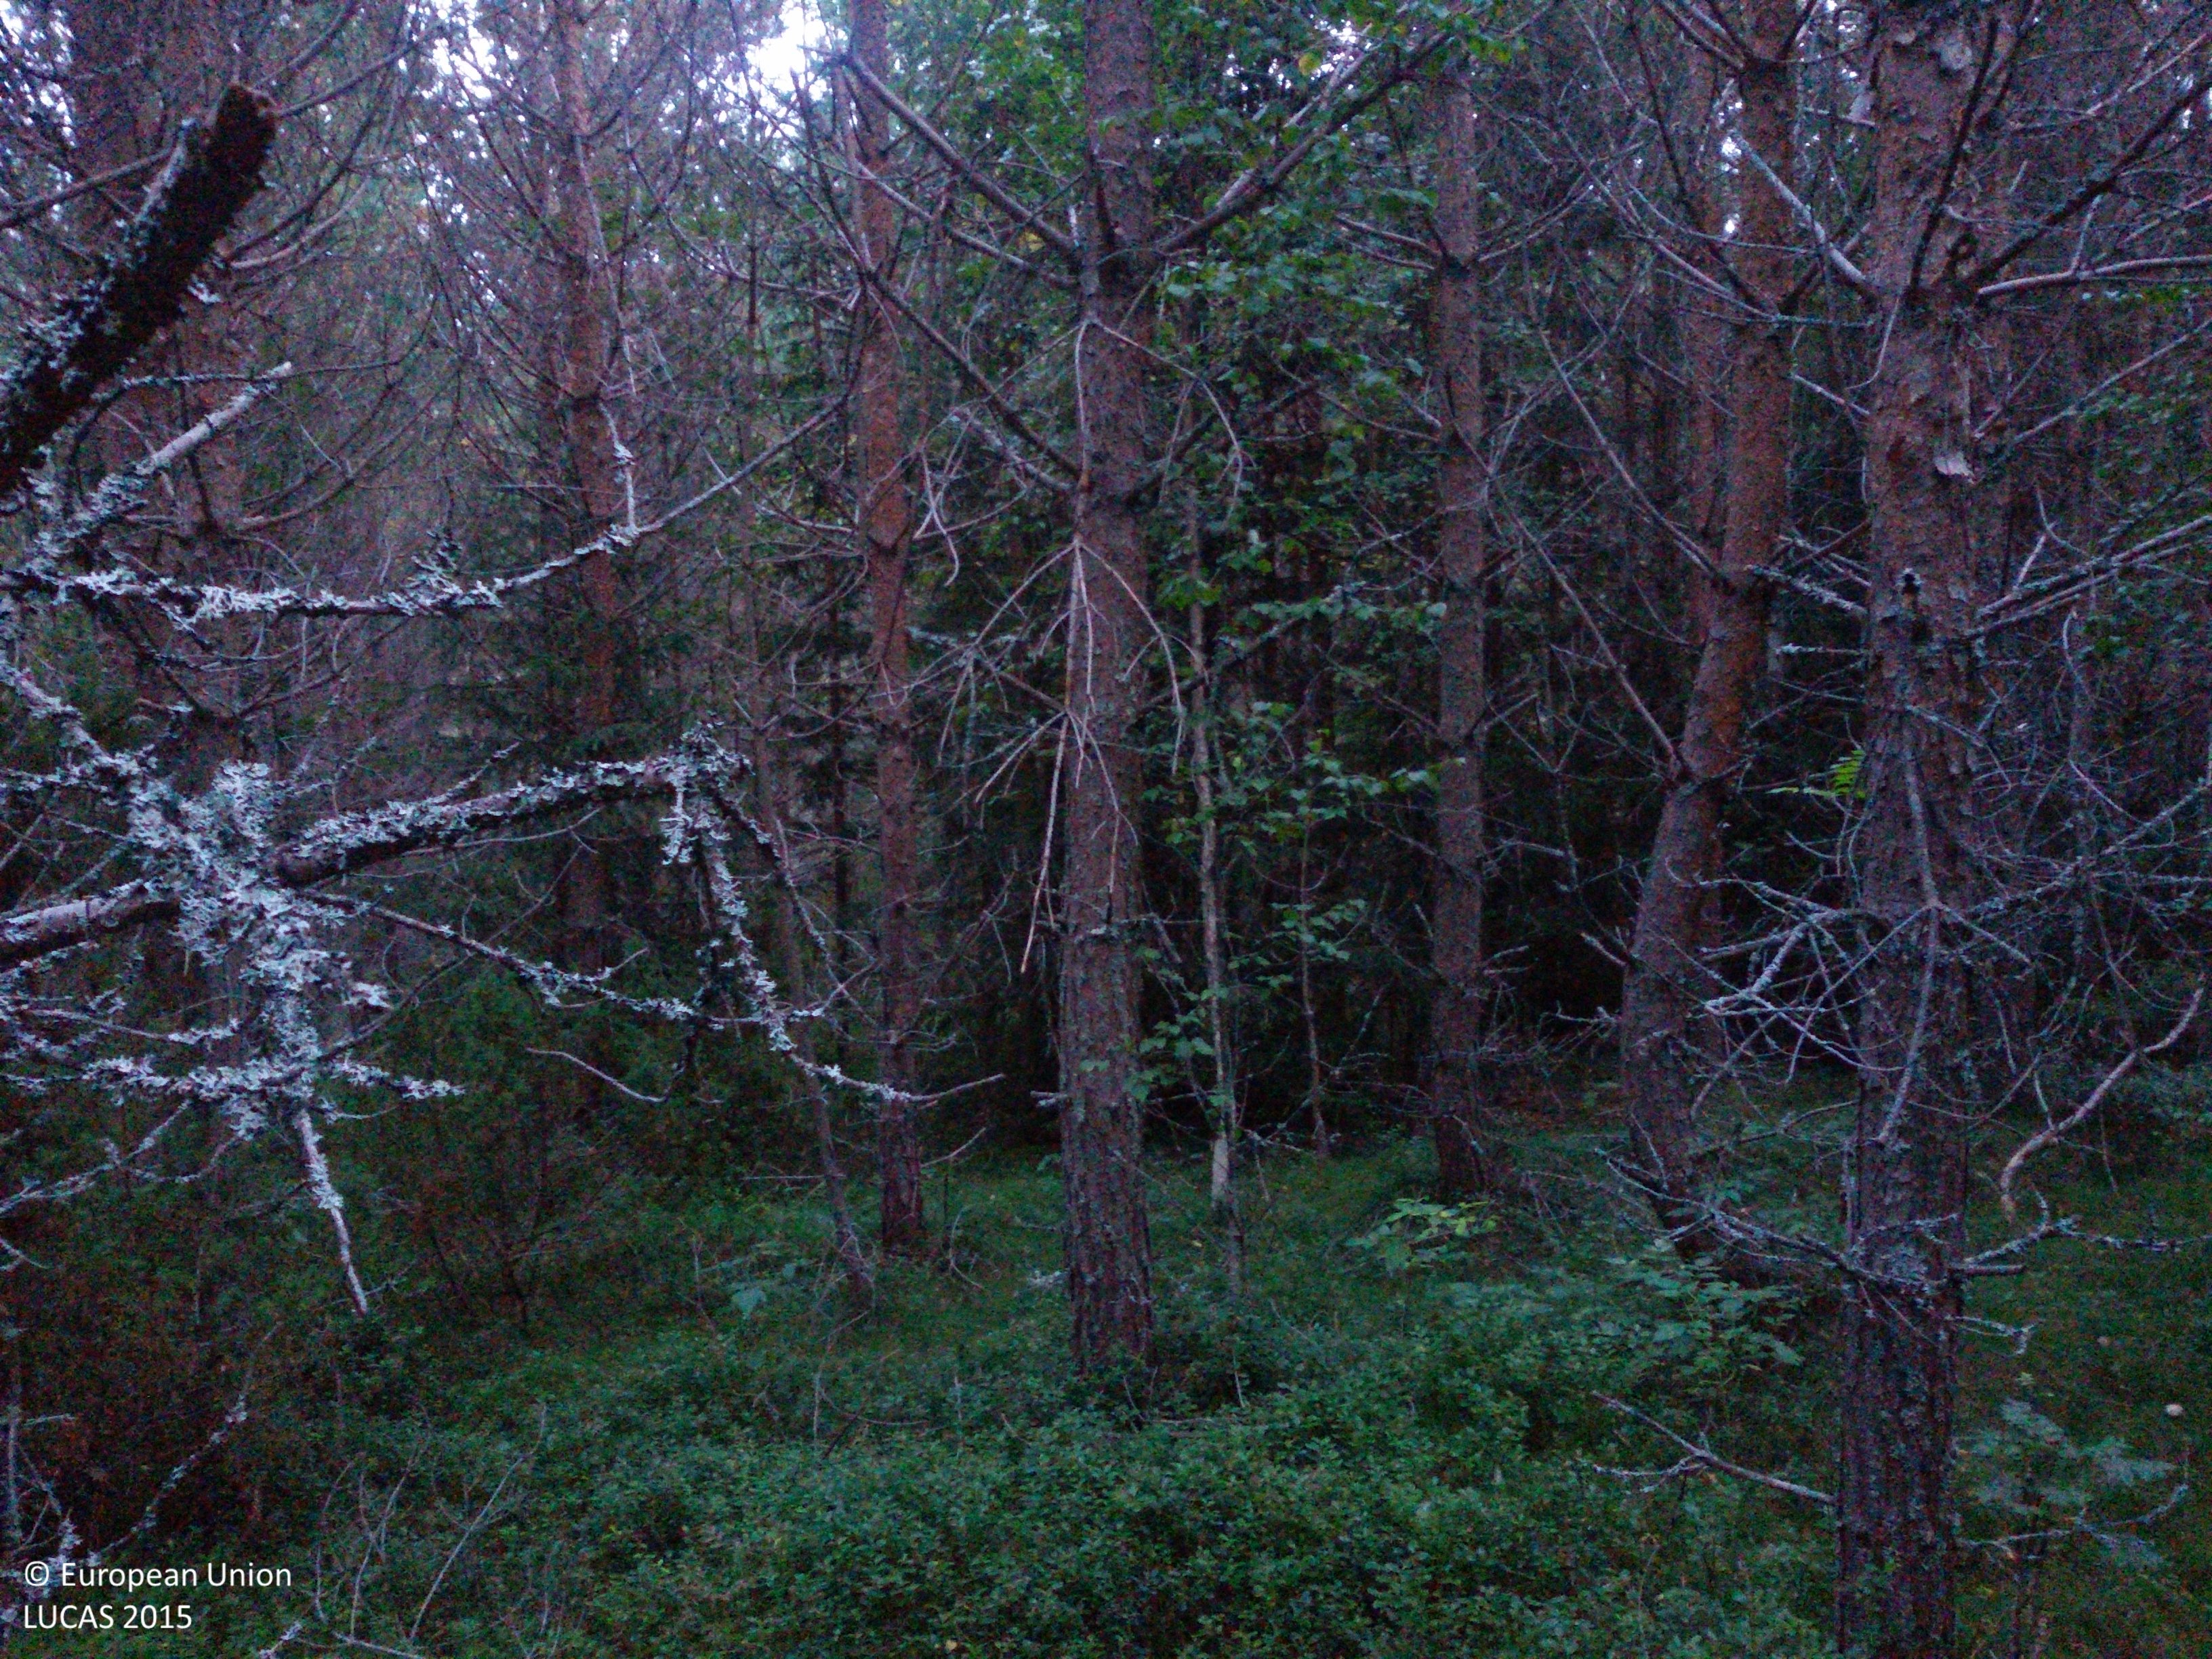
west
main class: Woodland
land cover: Pine dominated coniferous woodland
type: boreal forest
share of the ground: > 75 %
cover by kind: coniferous forest trees 80 %, shrubs 15 %, lichens and mosses 5 %
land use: Forestry
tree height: > 5 m
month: September
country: SE
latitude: 60.7148
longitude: 15.2468
